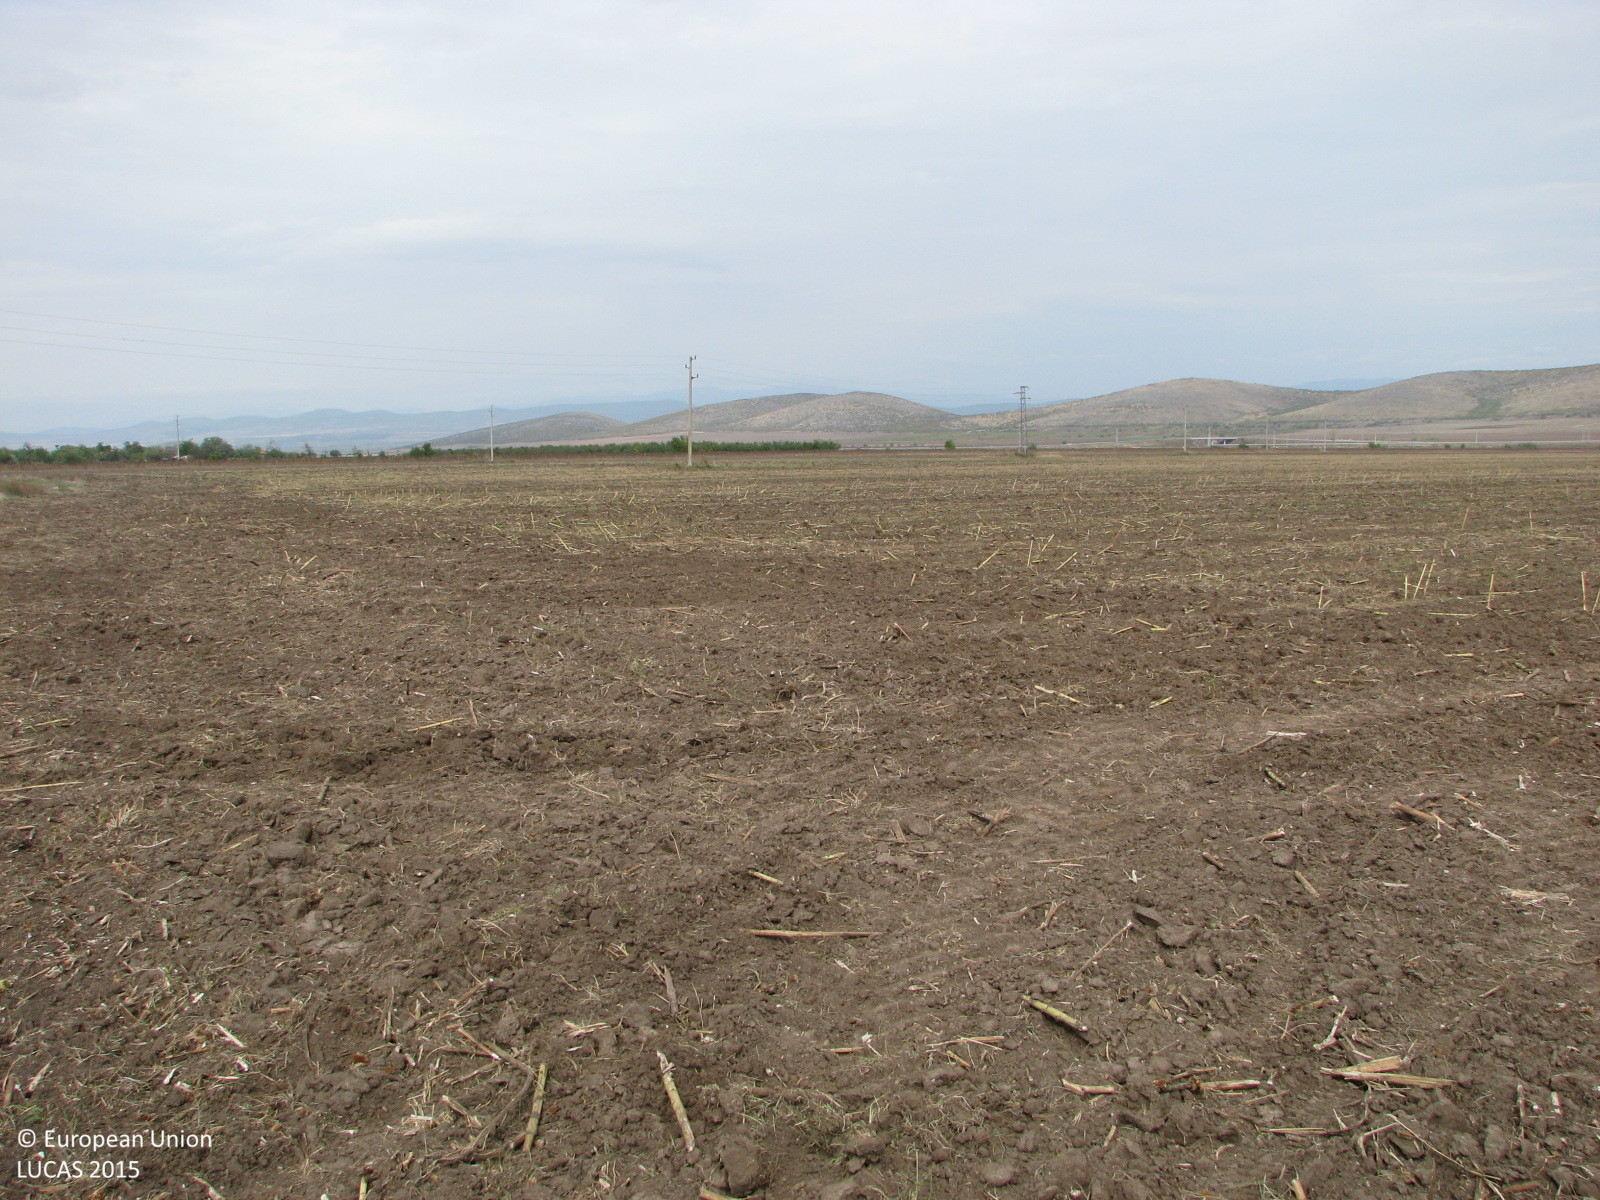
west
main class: Cropland
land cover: Sunflower
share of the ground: < 10 %
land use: Agriculture (excluding fallow land and kitchen gardens)
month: October
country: BG
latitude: 42.4789
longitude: 26.2030
